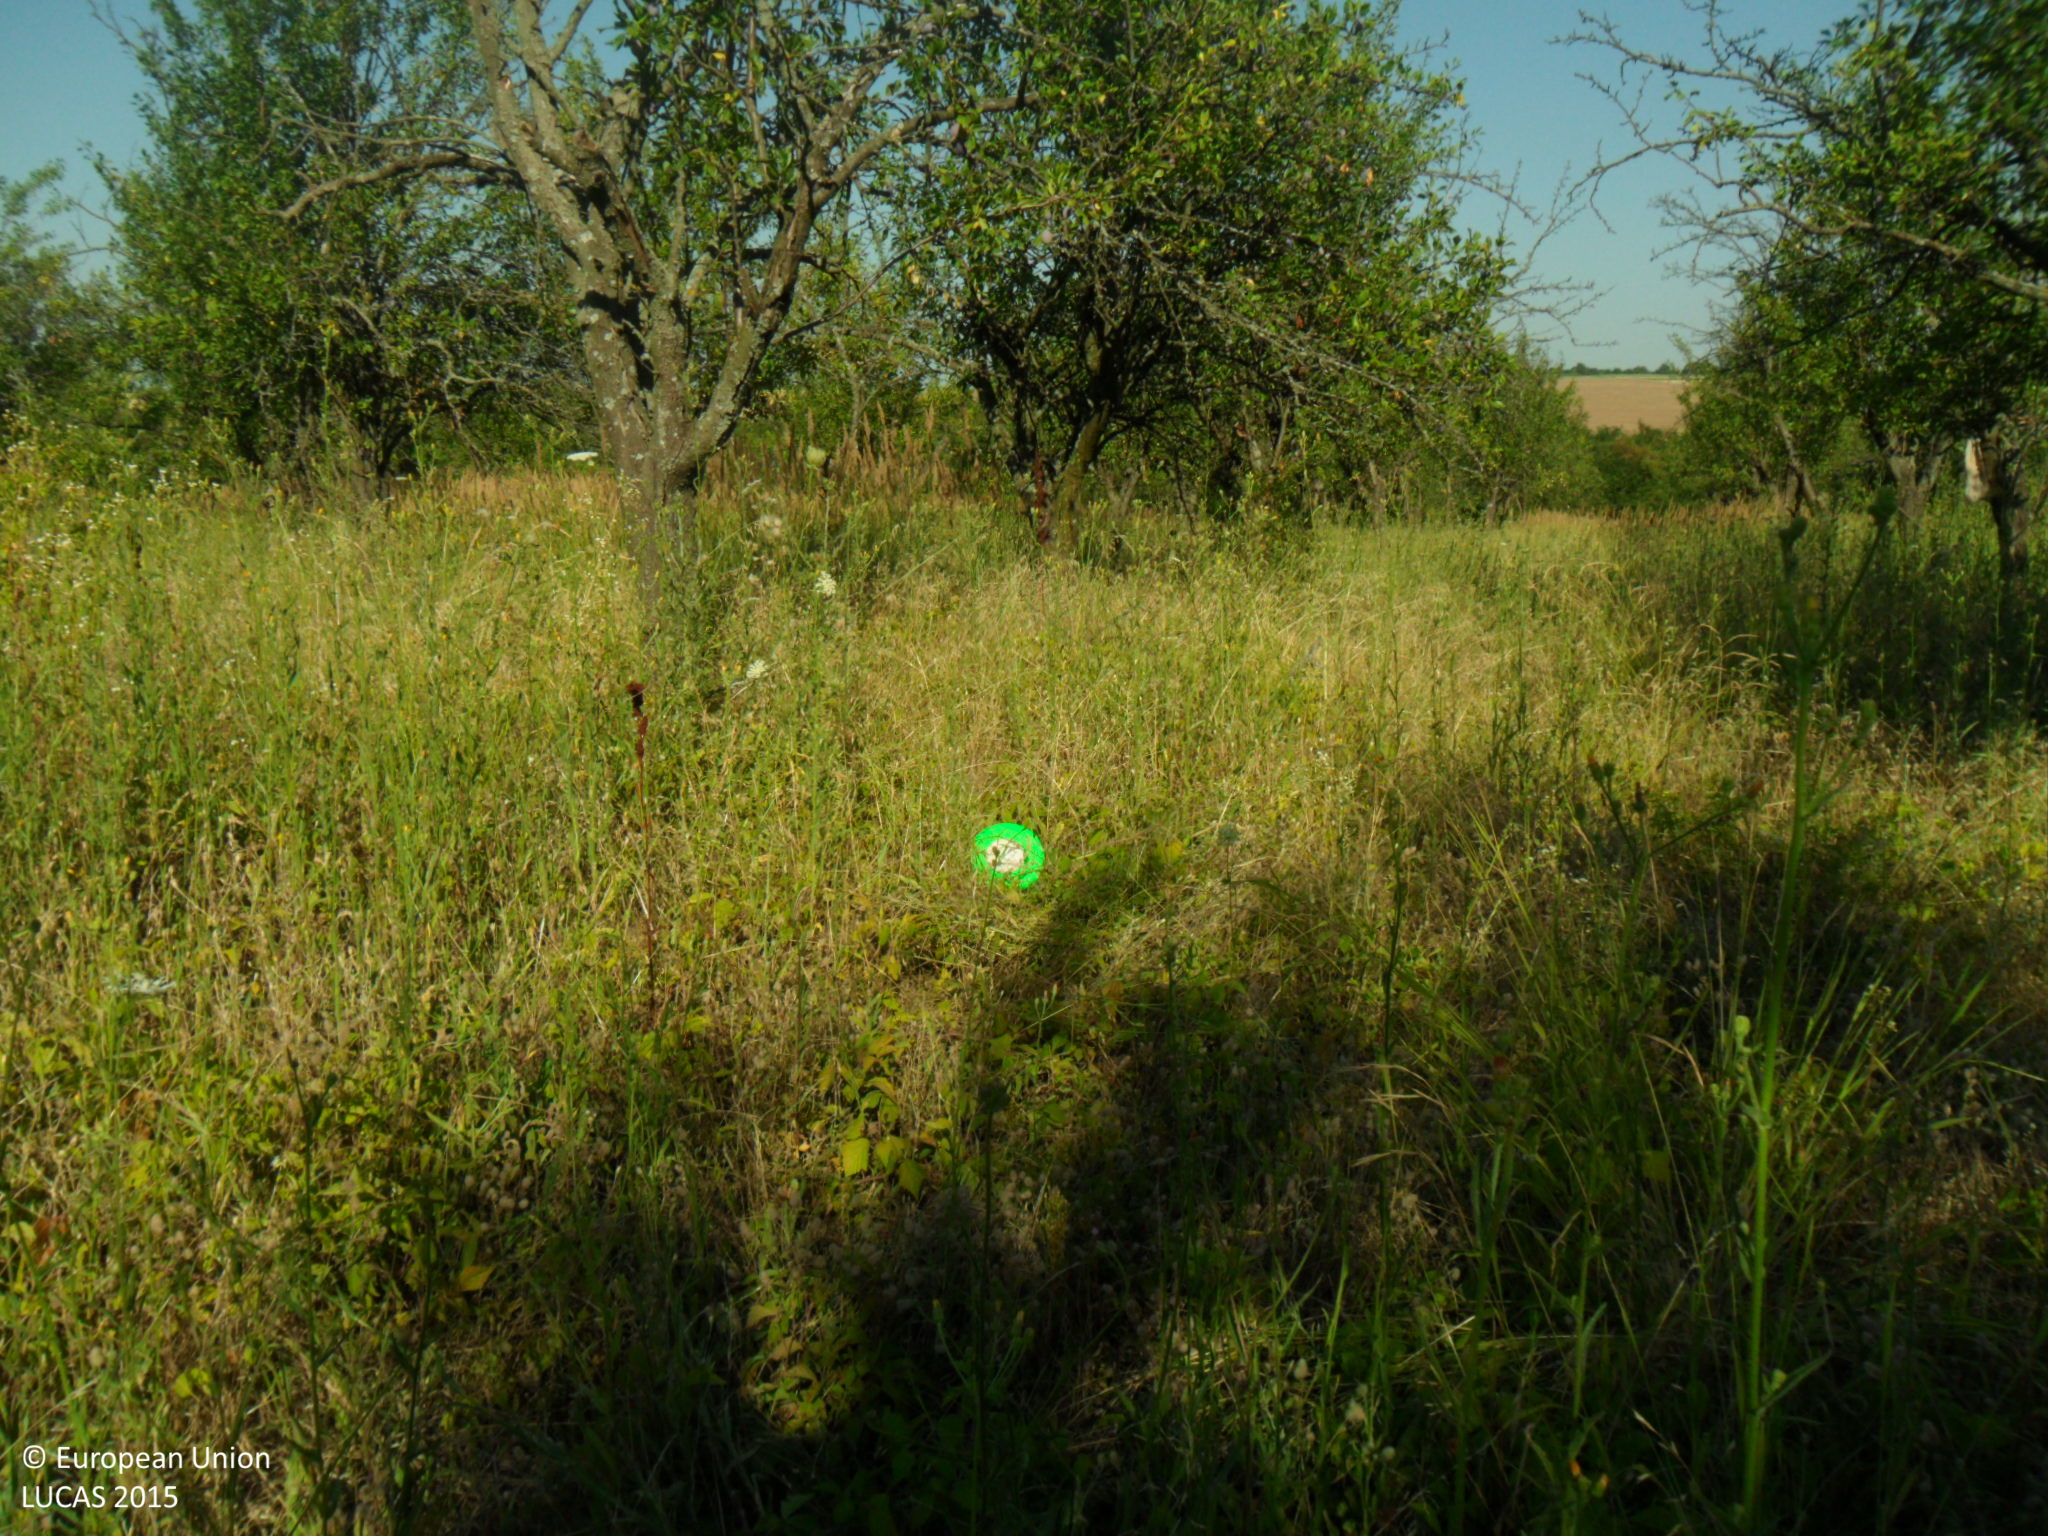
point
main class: Cropland
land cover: Other fruit trees and berries
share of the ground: 50 - 75 %
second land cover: Grassland without tree/shrub cover
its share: > 75 %
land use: Agriculture (excluding fallow land and kitchen gardens)
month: July
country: BG
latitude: 43.8274
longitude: 26.6123
